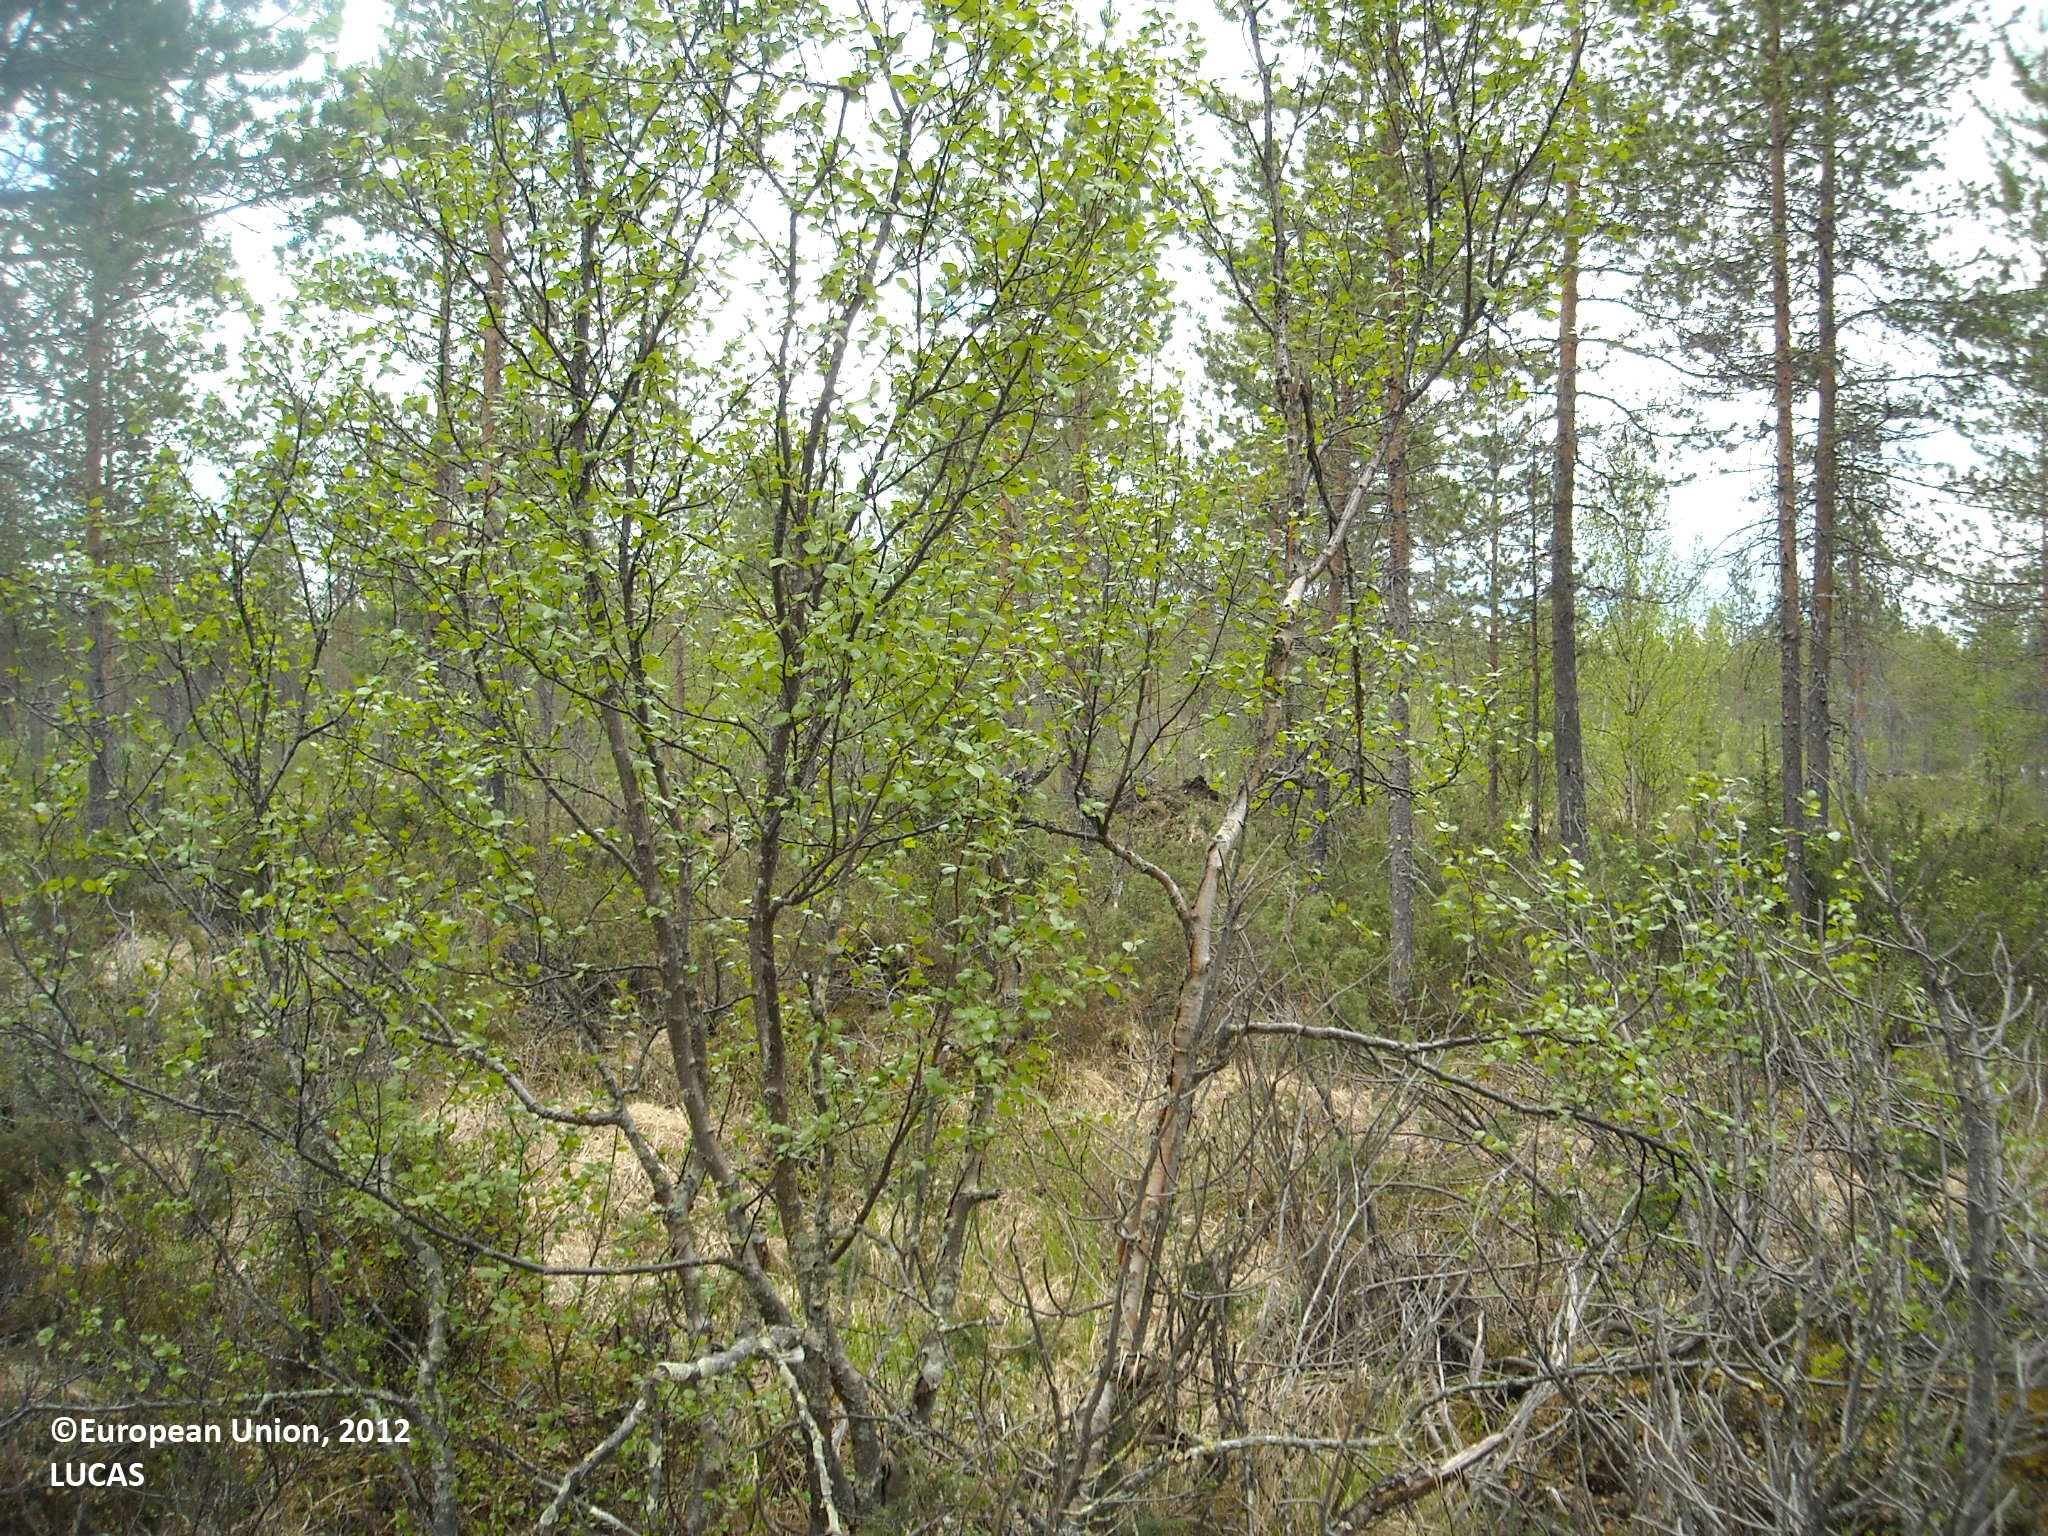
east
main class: Woodland
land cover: Pine dominated mixed woodland
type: mire and swamp forests
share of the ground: > 75 %
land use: Forestry
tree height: > 5 m
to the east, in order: Pine dominated mixed woodland; Ditches and canals; Pine dominated mixed woodland; Ditches and canals; Pine dominated coniferous woodland; Pine dominated mixed woodland; Ditches and canals; Pine dominated coniferous woodland; Ditches and canals; Other mixed woodland; Ditches and canals; Other bare soil; Other mixed woodland; Ditches and canals; Other mixed woodland; Ditches and canals; Other mixed woodland; Ditches and canals; Other mixed woodland; Ditches and canals; Other mixed woodland
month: June
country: FI
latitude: 65.3294
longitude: 27.8566
